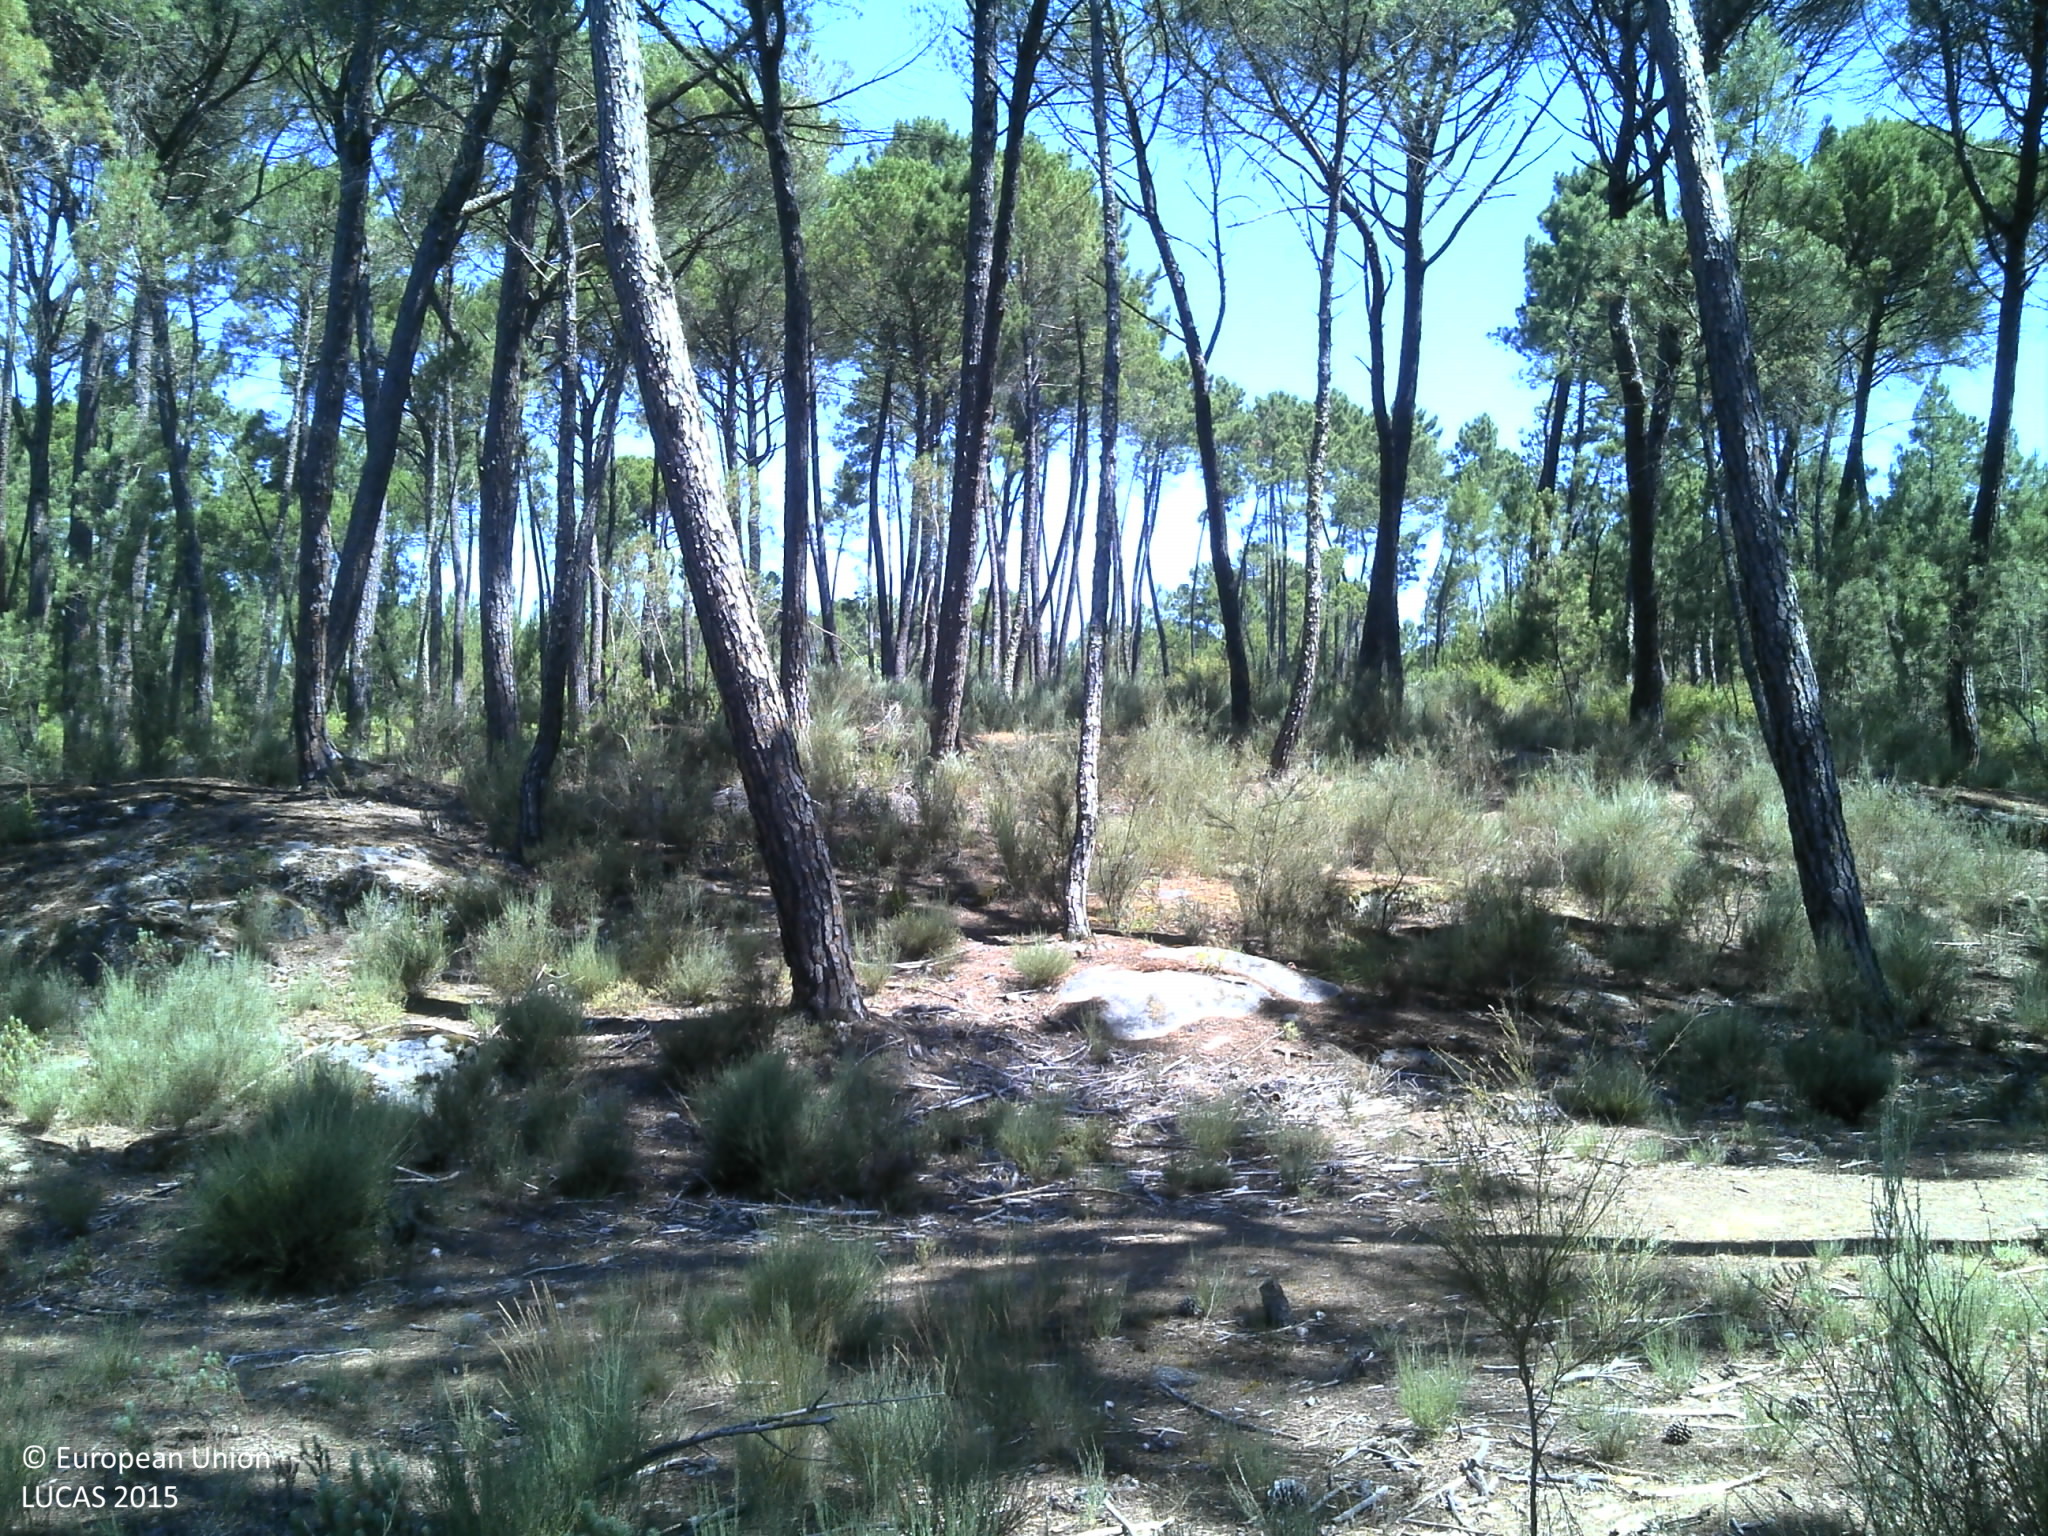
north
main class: Woodland
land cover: Pine dominated coniferous woodland
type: coniferous forest of the mediterranean region
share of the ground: 50 - 75 %
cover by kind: coniferous forest trees 70 %, shrubs 25 %, herbaceous plants 5 %
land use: Forestry
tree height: > 5 m
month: June
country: PT
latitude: 40.5729
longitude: -7.8520
